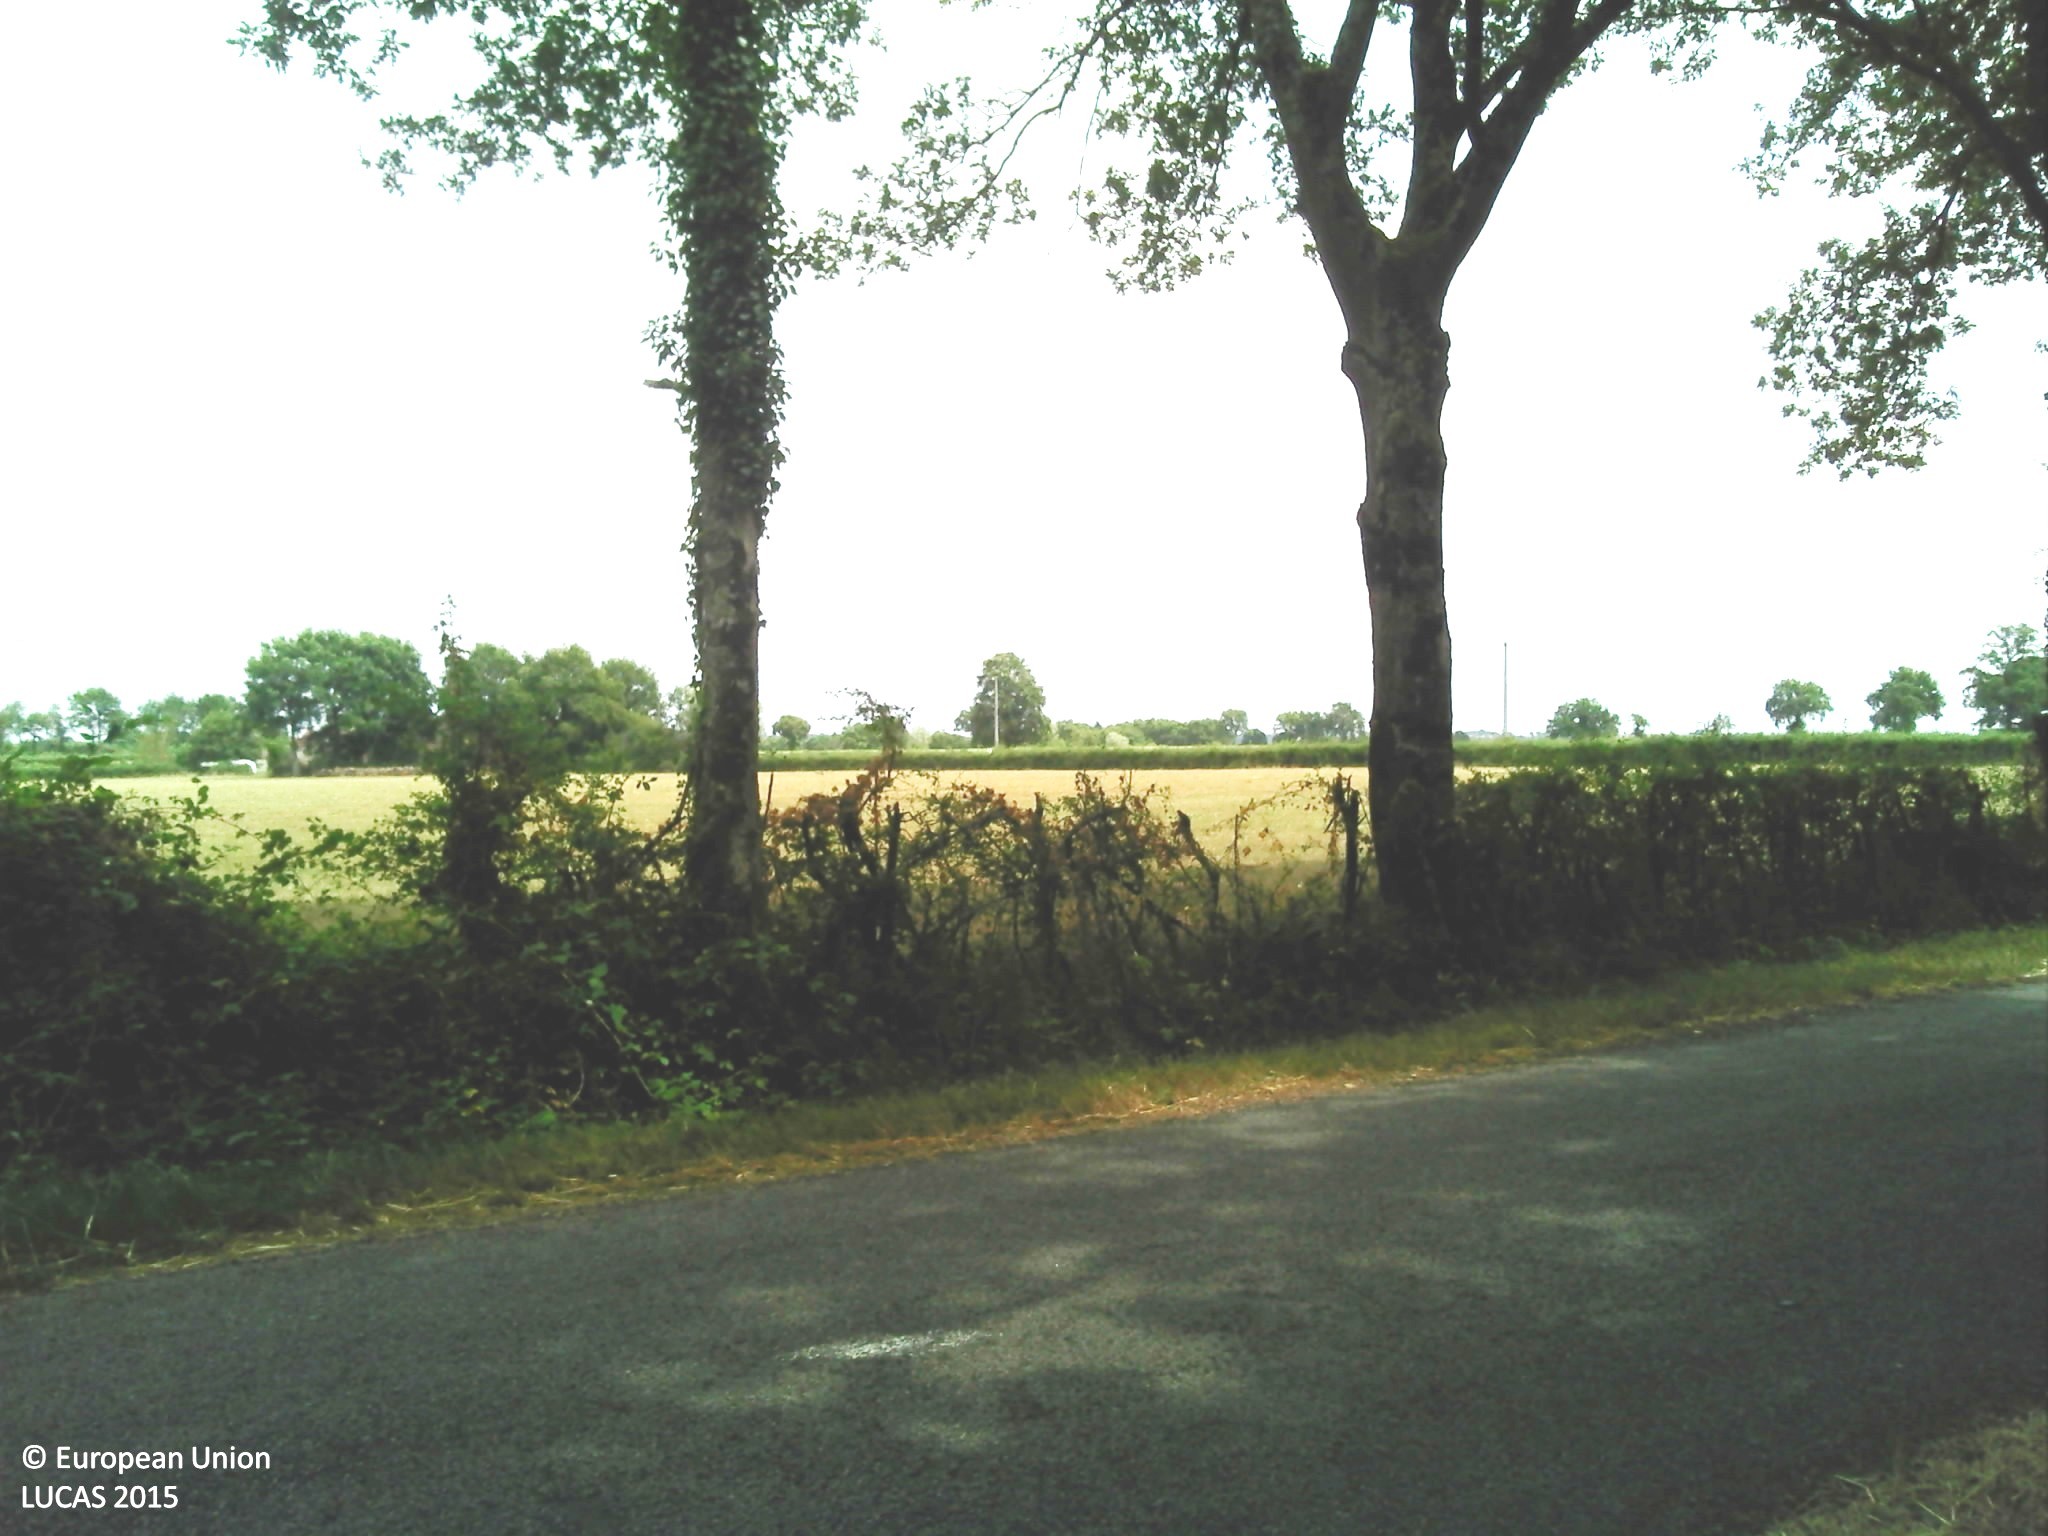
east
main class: Woodland
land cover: Broadleaved woodland
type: mesophytic deciduous forest
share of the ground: > 75 %
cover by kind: broadleaved forest trees 90 %, shrubs 5 %, herbaceous plants 5 %
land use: Forestry
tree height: > 5 m
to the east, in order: Broadleaved woodland
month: July
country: FR
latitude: 46.6430
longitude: 2.9548
